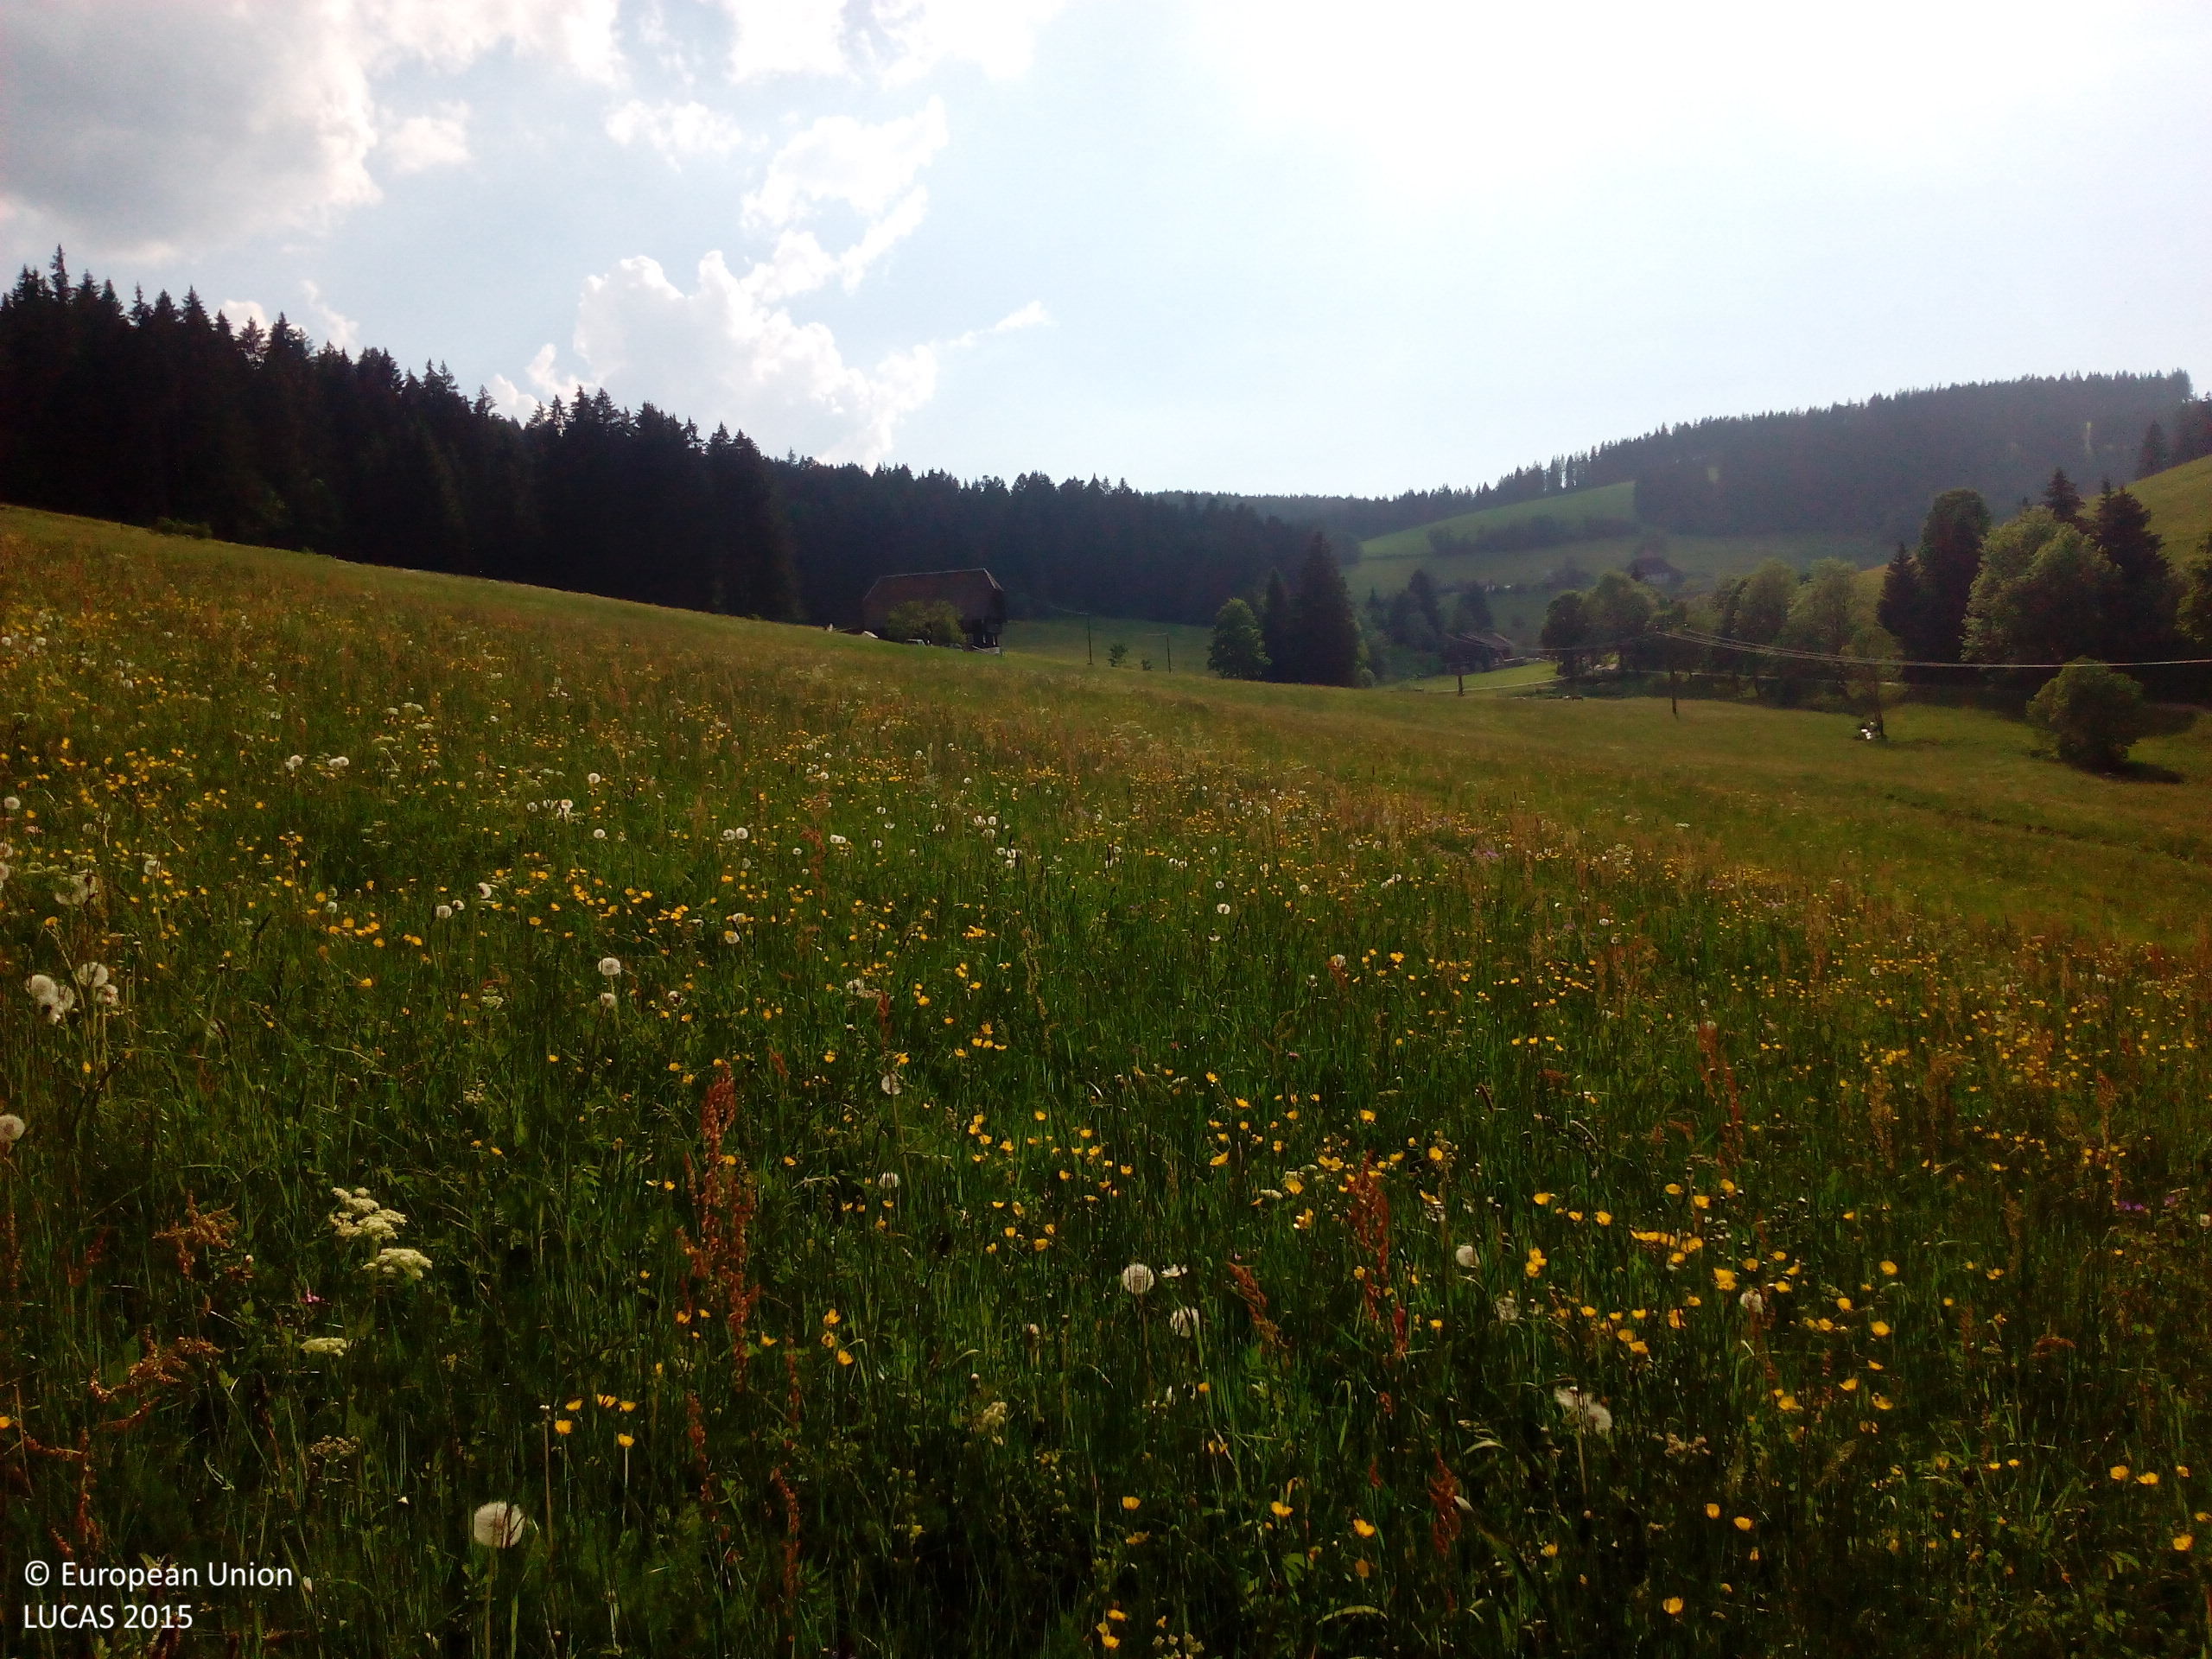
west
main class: Grassland
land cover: Grassland without tree/shrub cover
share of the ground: > 75 %
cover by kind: herbaceous plants 100 %
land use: Agriculture (excluding fallow land and kitchen gardens)
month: June
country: DE
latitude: 47.9558
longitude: 8.1397
